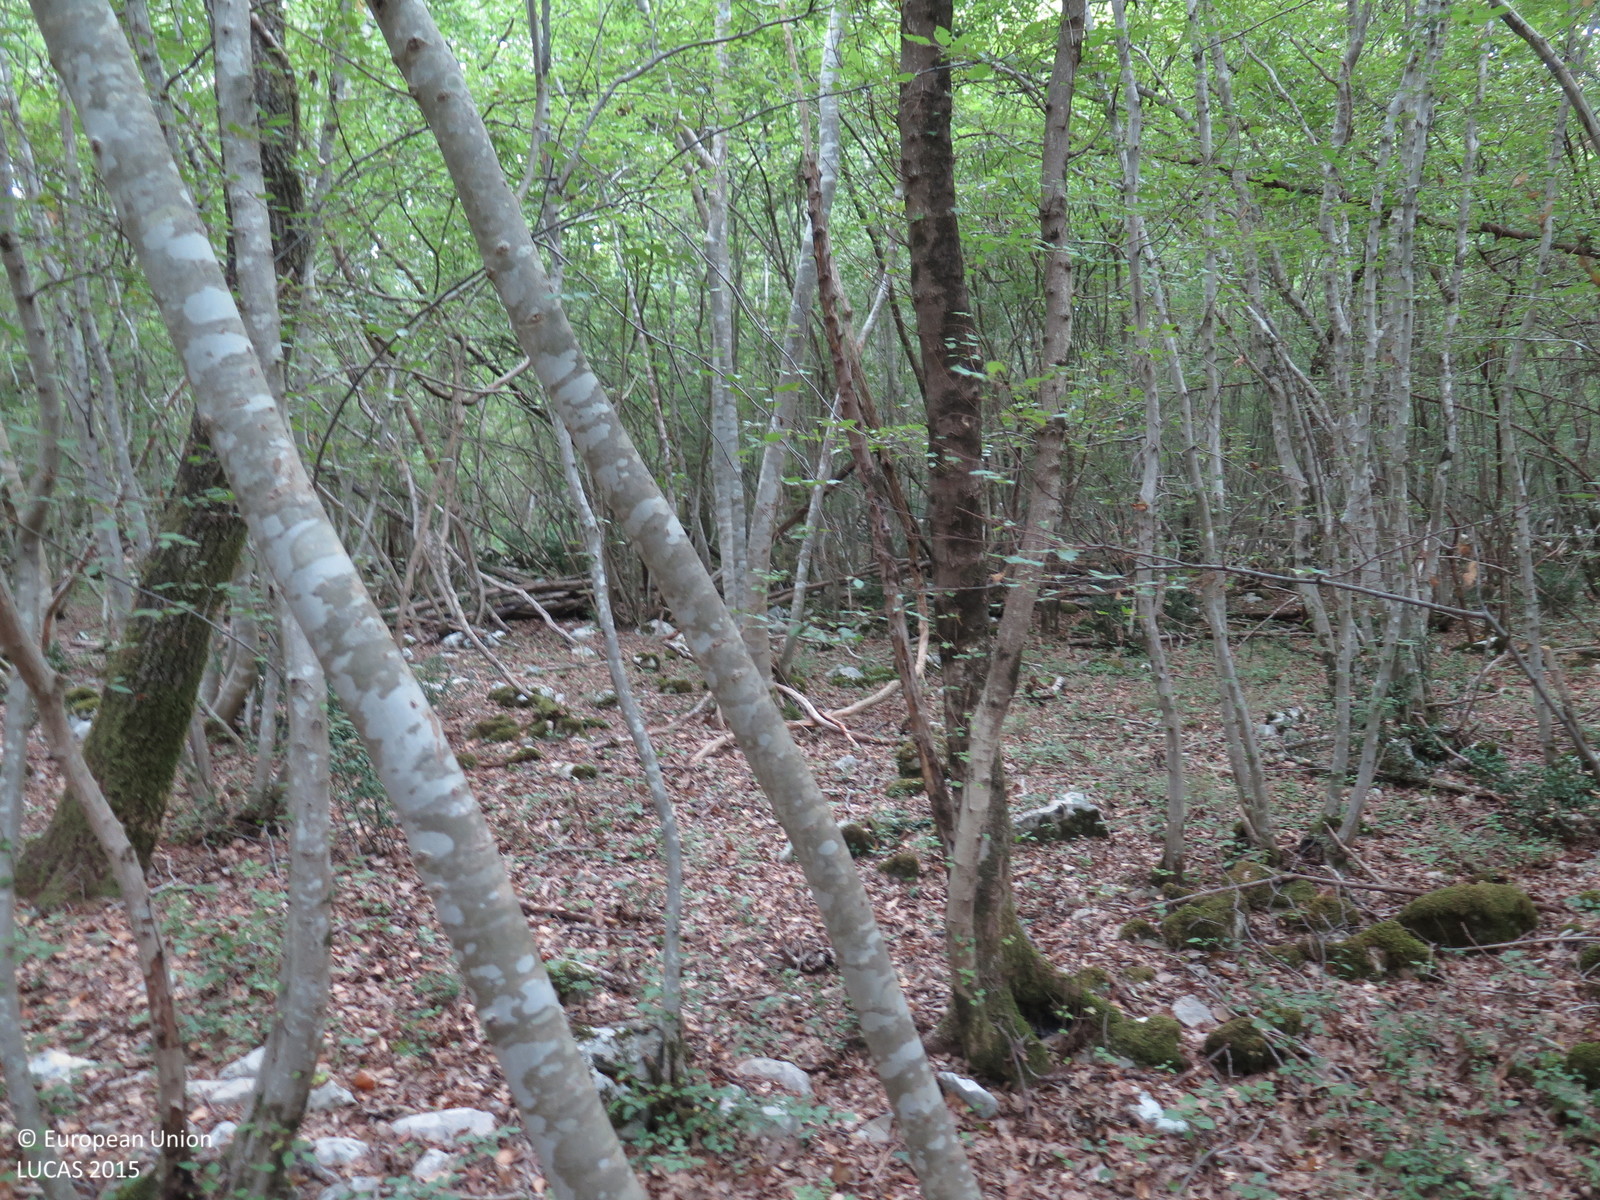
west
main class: Woodland
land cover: Broadleaved woodland
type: beech forest
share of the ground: > 75 %
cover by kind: broadleaved forest trees 100 %
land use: Semi-natural and natural areas not in use
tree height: > 5 m
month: August
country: HR
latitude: 45.1139
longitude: 14.6341
